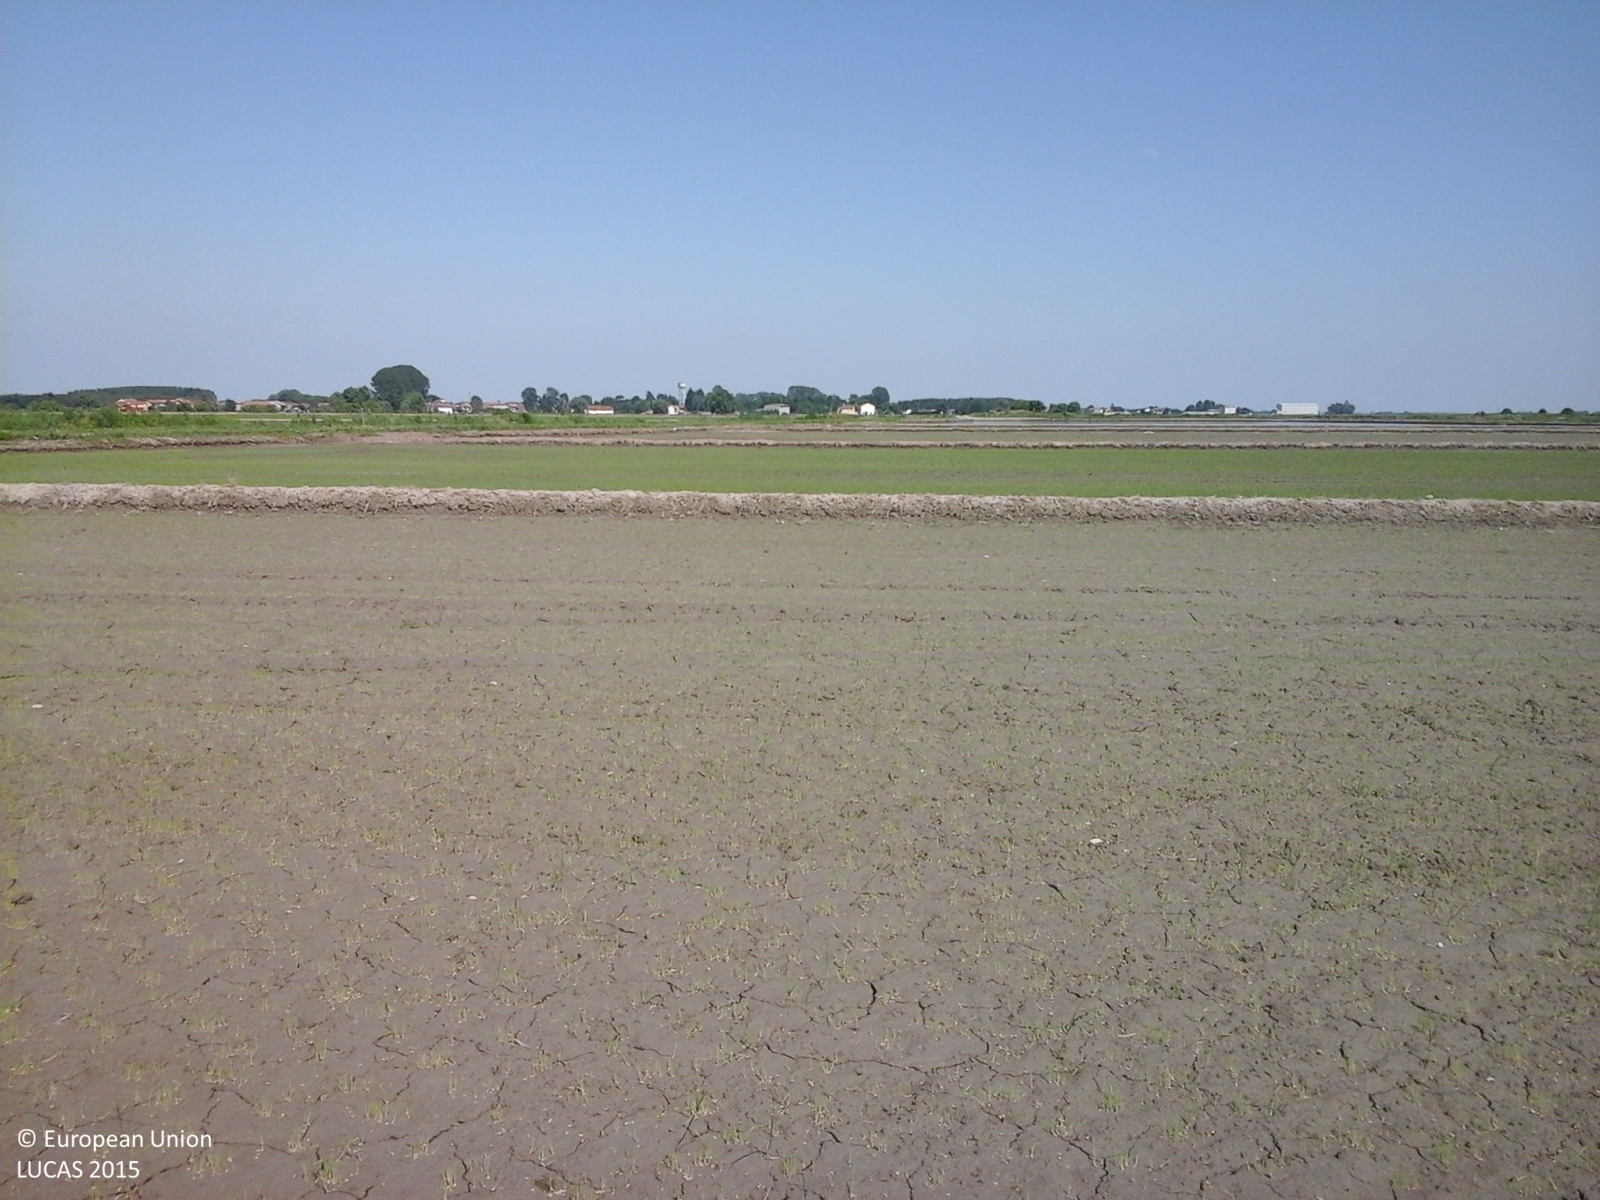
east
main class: Cropland
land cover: Rice
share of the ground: < 10 %
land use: Agriculture (excluding fallow land and kitchen gardens)
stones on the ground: < 10 %
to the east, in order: Rice; Other structural elements; Rice; Other structural elements; Rice; Other structural elements; Rice; Other structural elements; Rice; Other structural elements; Grass margins; Ditches and canals; Grass margins; Tracks; Grass margins; Inland fresh running water; Spontaneously vegetated surfaces; Rice; Other structural elements; Rice
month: May
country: IT
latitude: 45.2577
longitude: 8.3845
